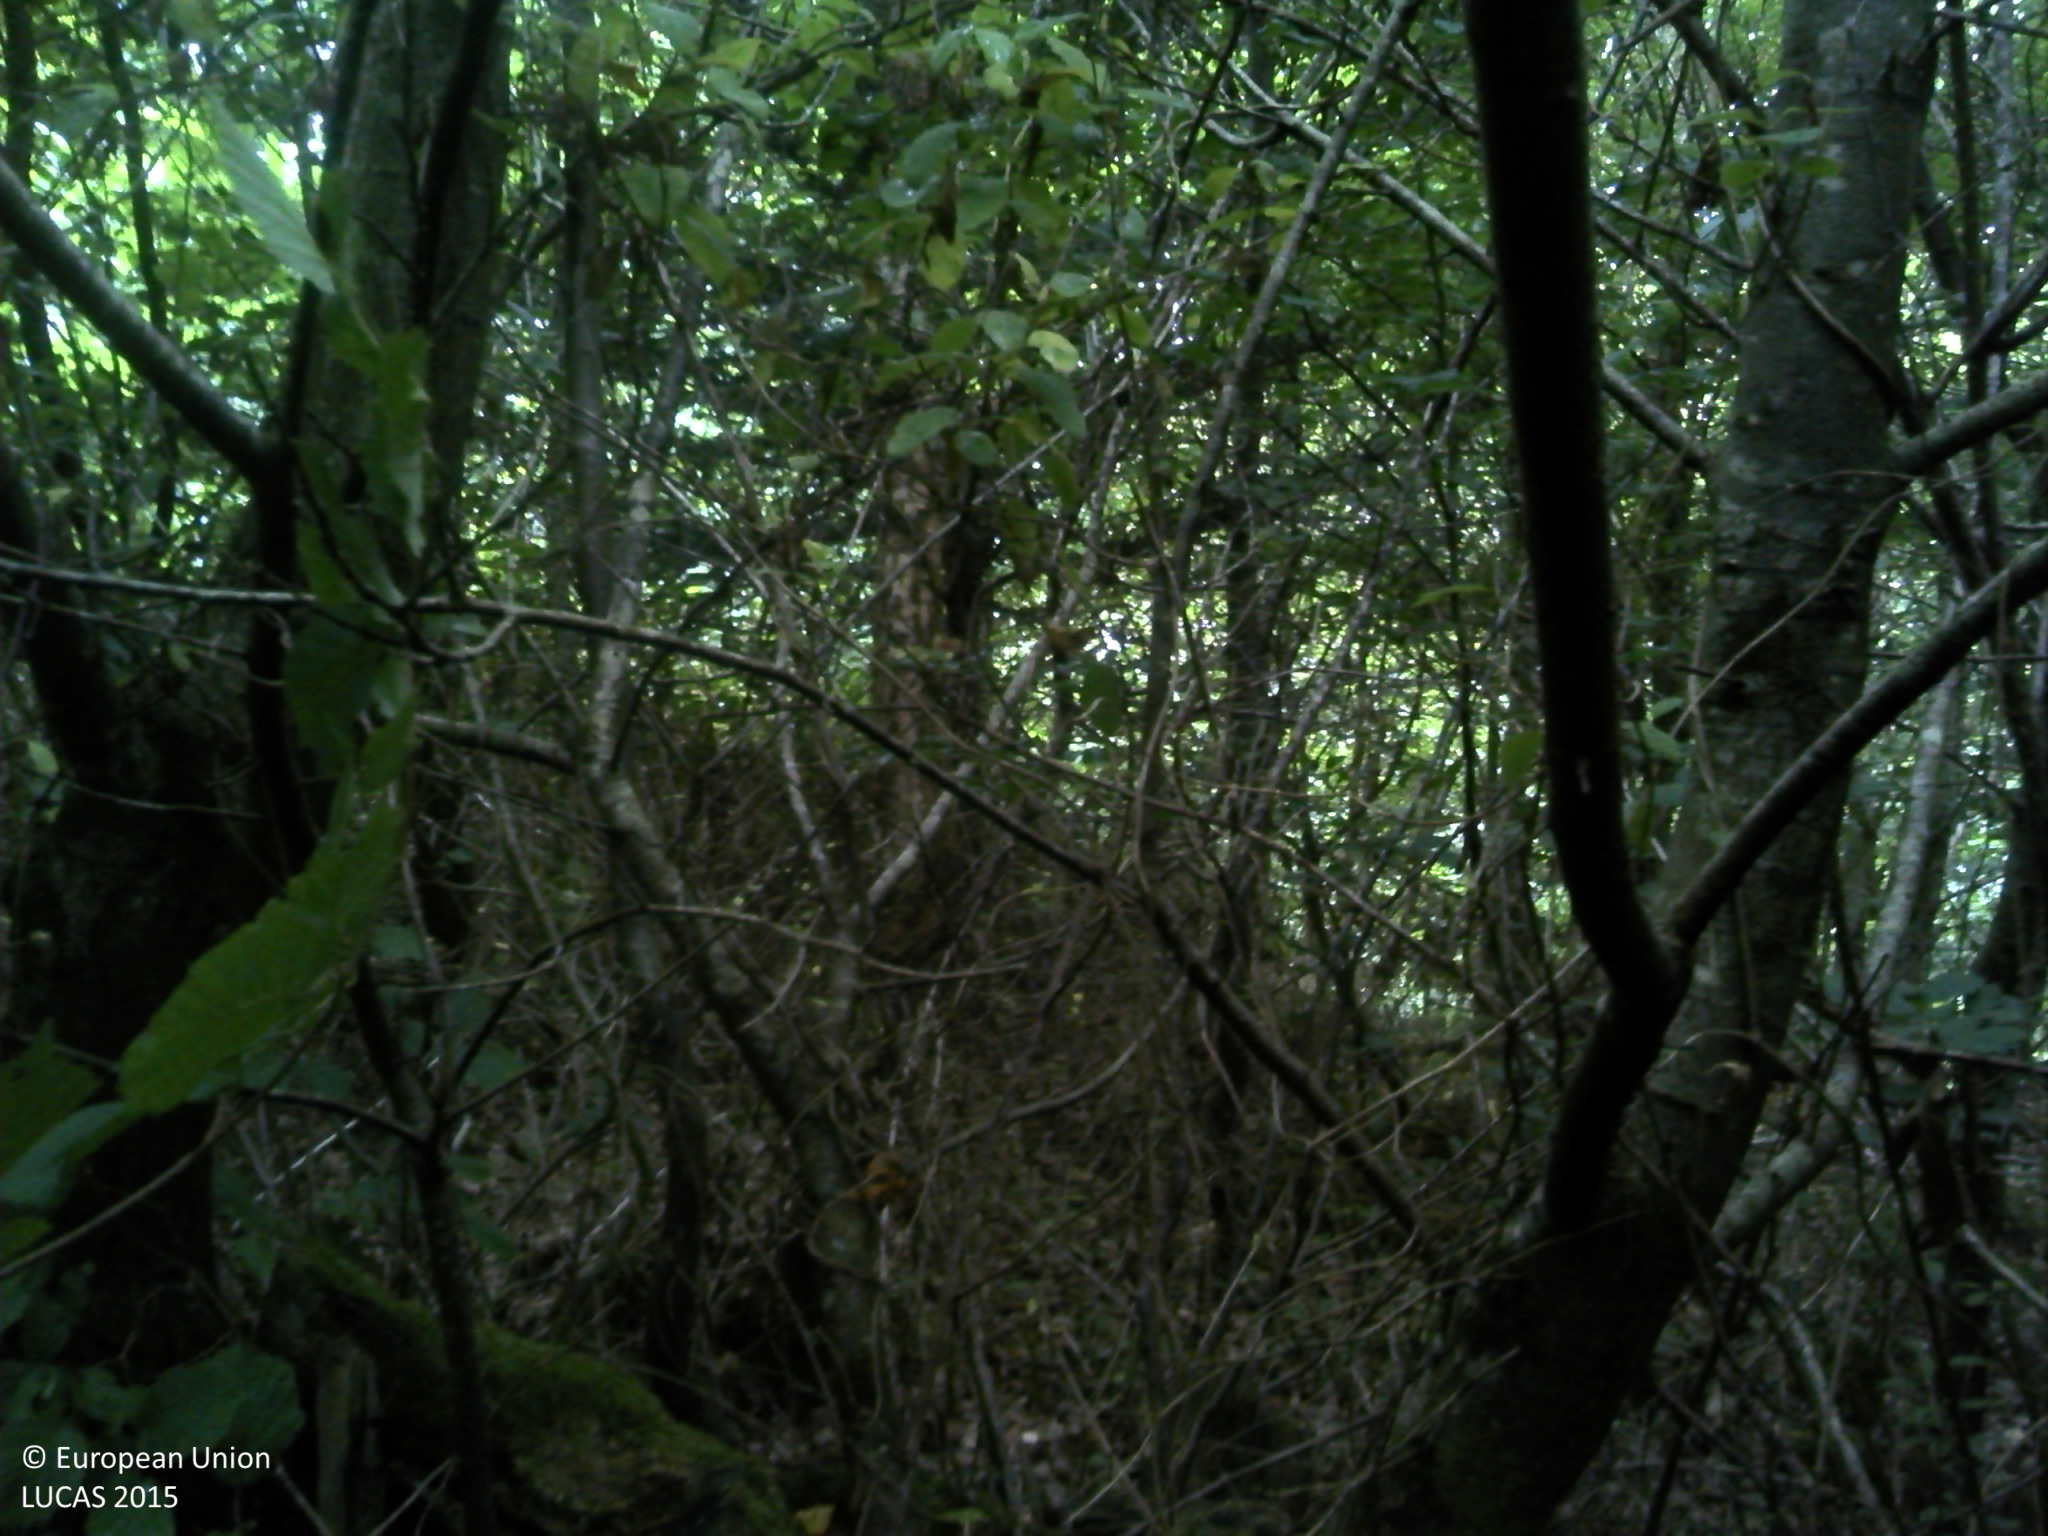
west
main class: Woodland
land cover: Broadleaved woodland
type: mesophytic deciduous forest
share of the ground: > 75 %
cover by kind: broadleaved forest trees 90 %, shrubs 10 %
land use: Forestry
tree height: > 5 m
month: July
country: FR
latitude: 48.4431
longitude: -4.2474
